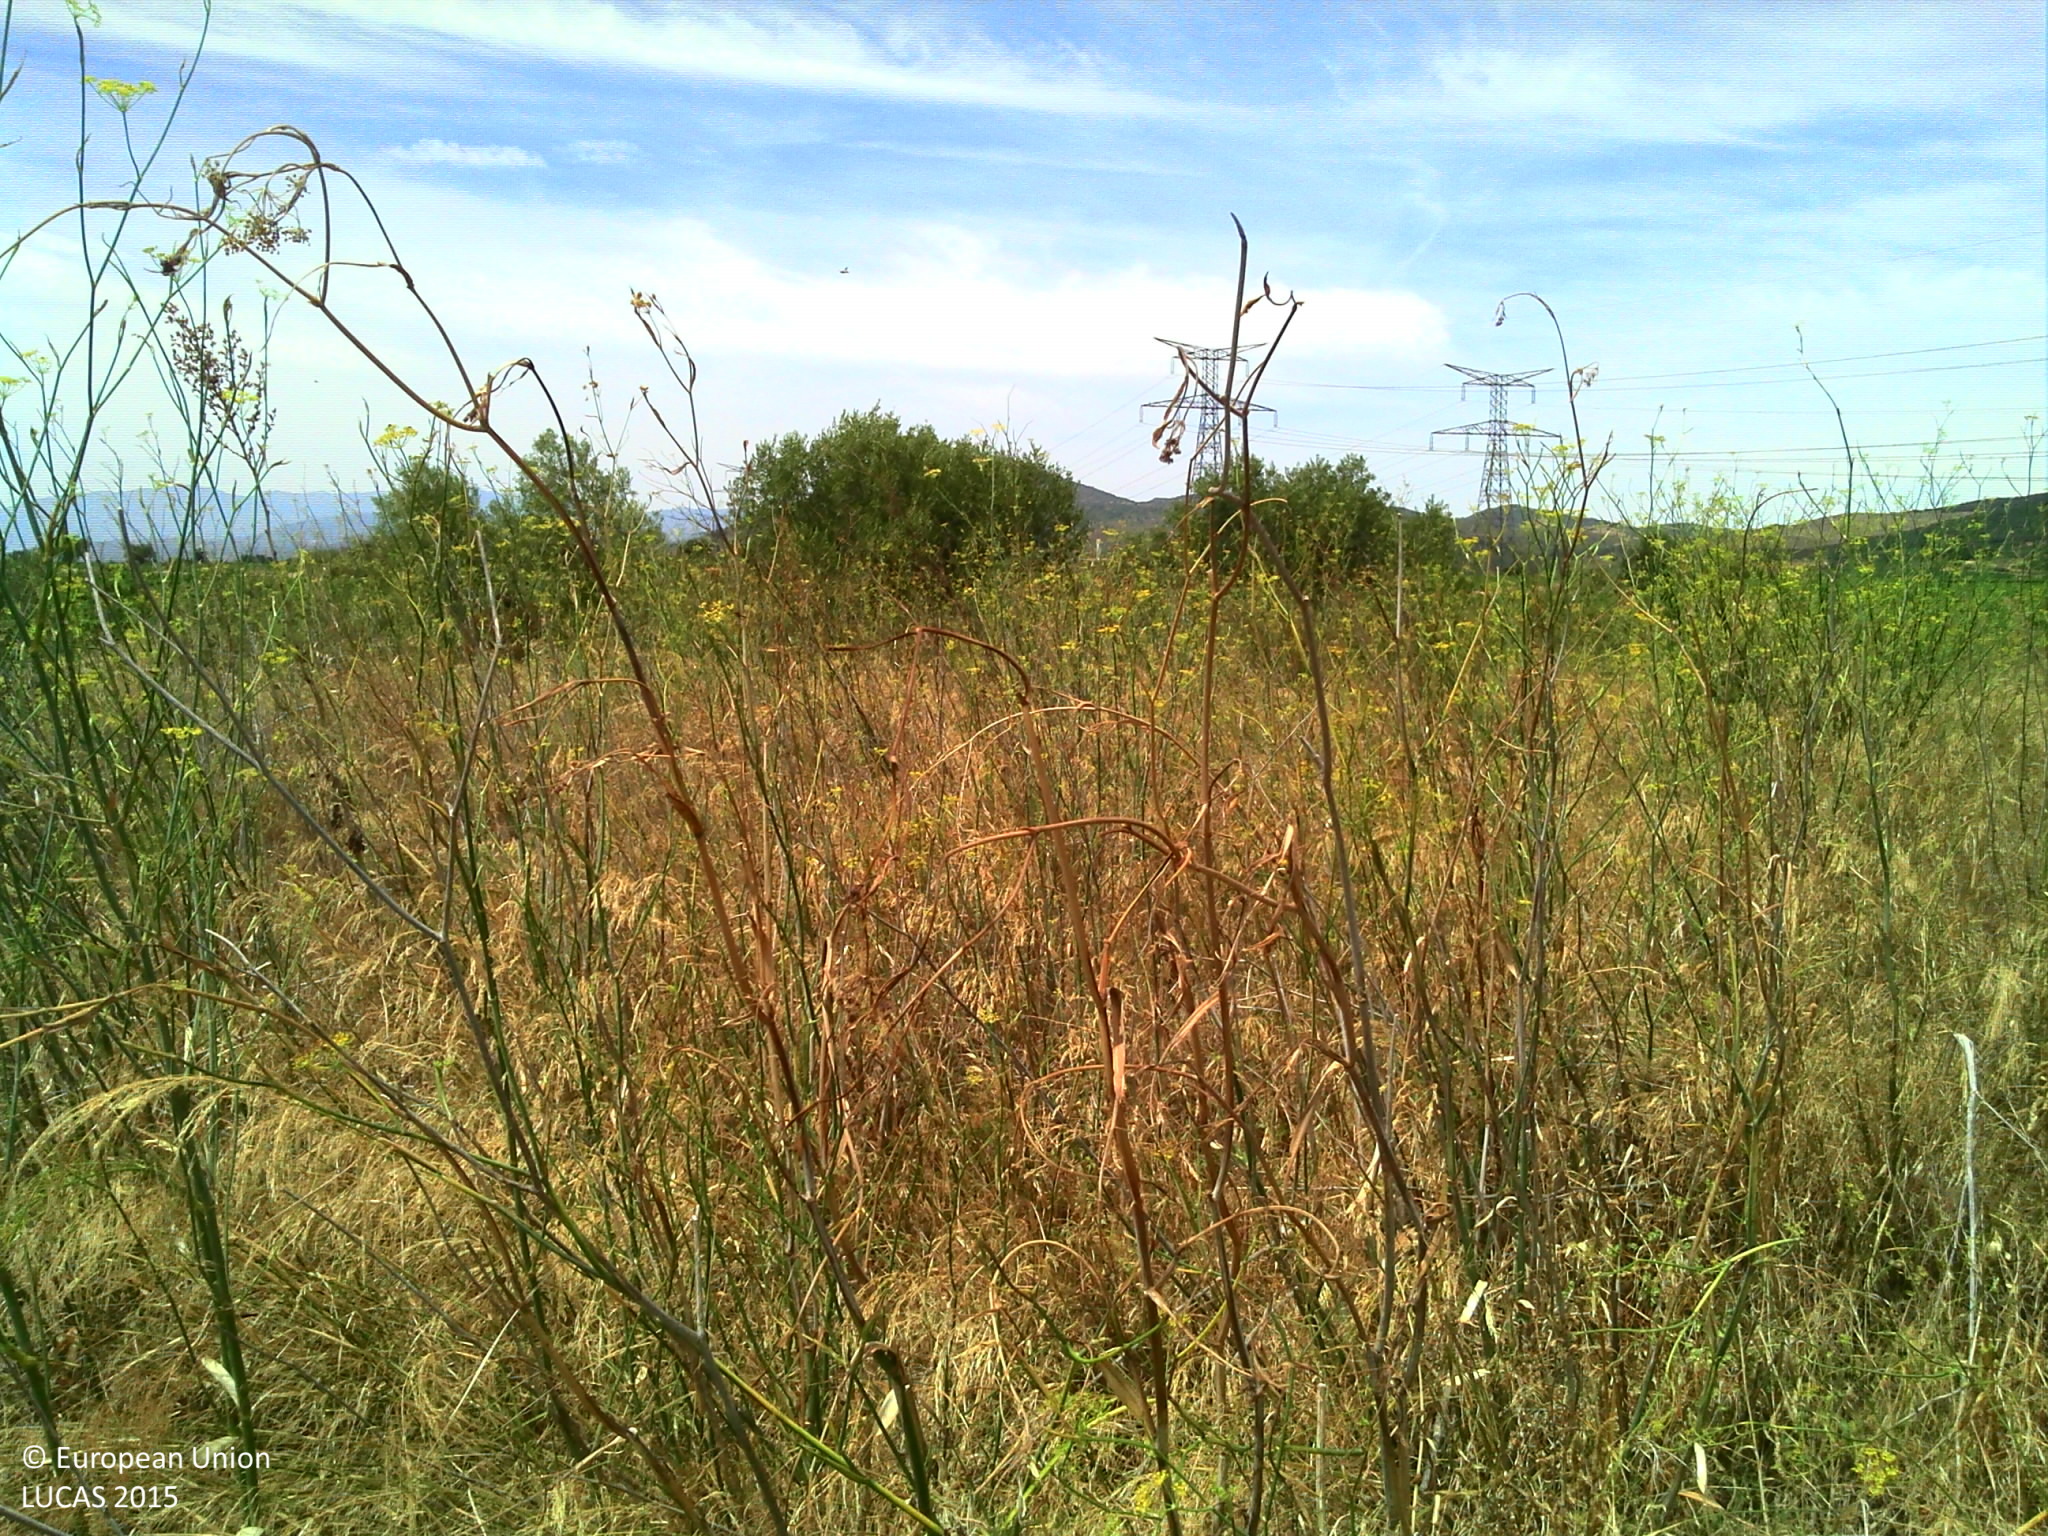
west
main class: Shrubland
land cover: Shrubland without tree cover
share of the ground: > 75 %
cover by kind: shrubs 60 %, herbaceous plants 40 %
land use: Energy production
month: July
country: FR
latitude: 42.7217
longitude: 2.7700
